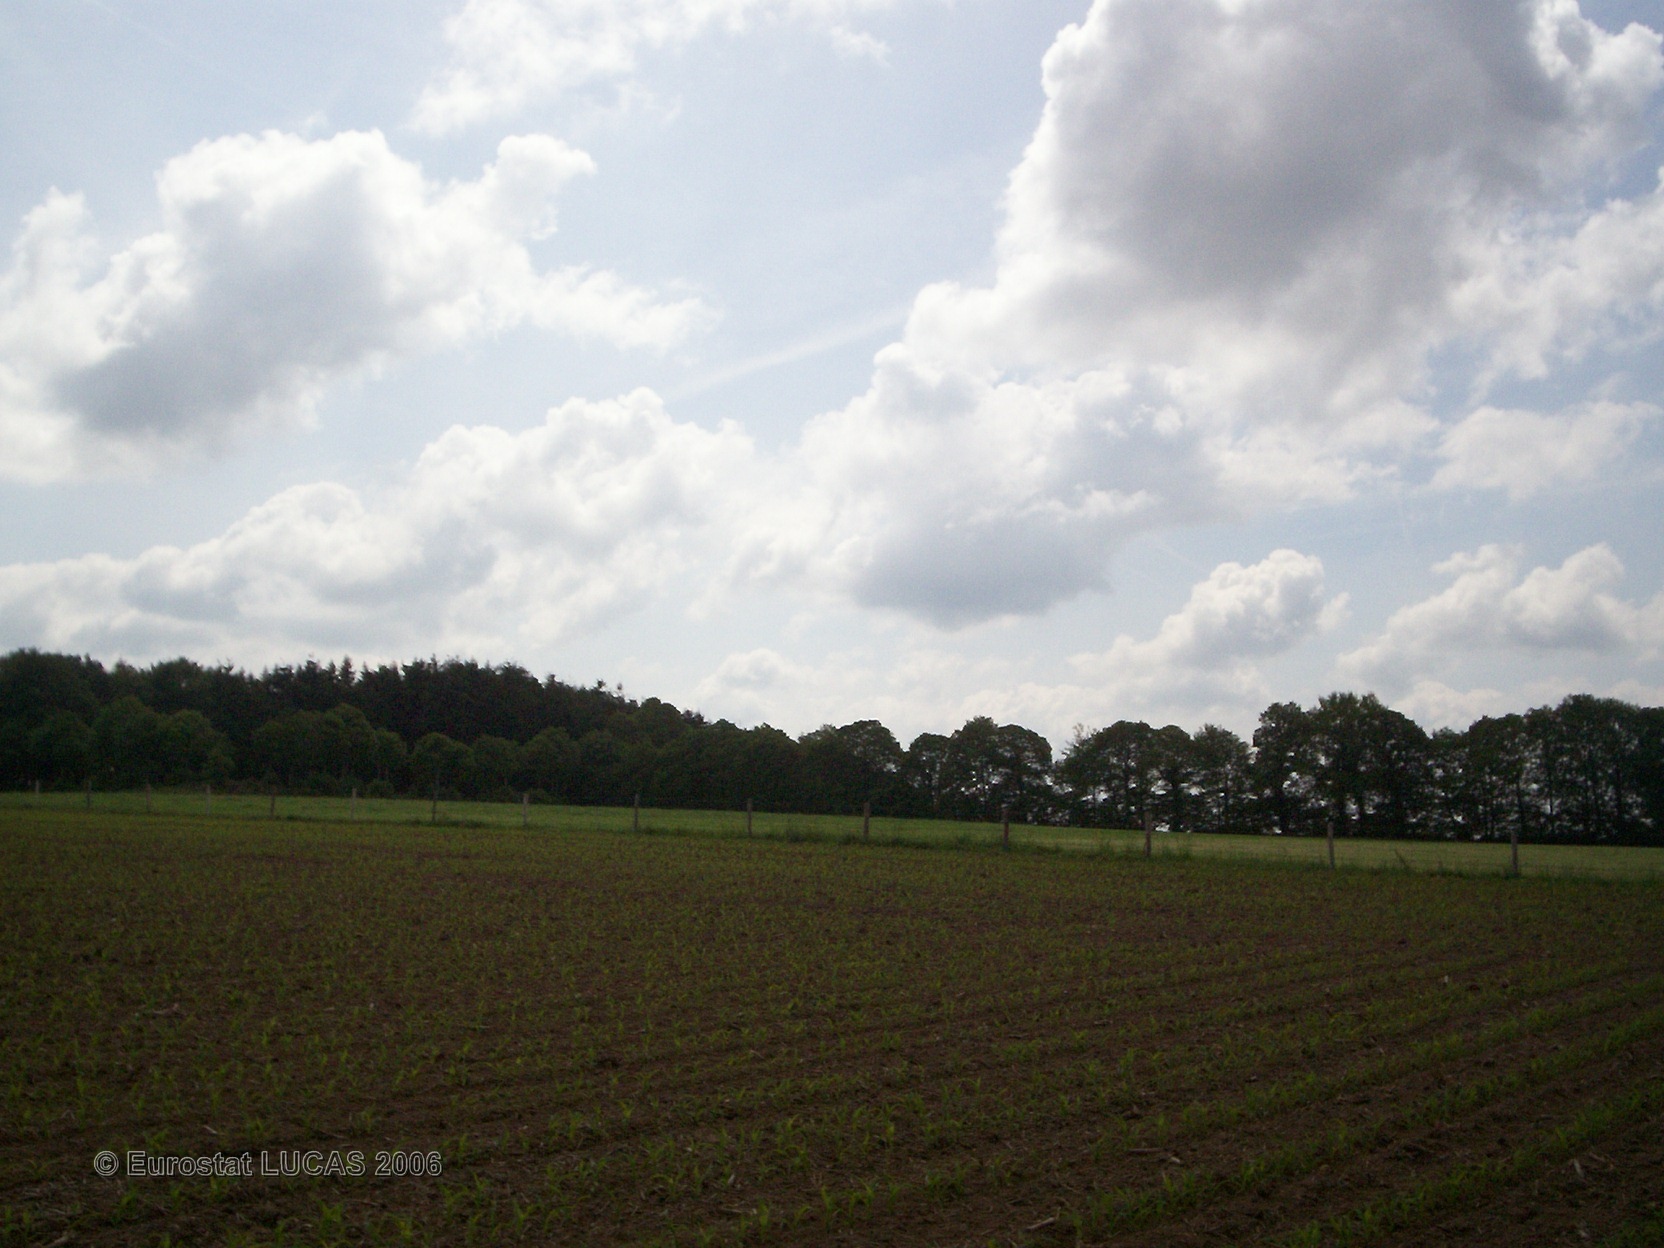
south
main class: Cropland
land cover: Maize
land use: Agriculture (excluding fallow land and kitchen gardens)
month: June
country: FR
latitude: 48.4476
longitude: -1.2241
